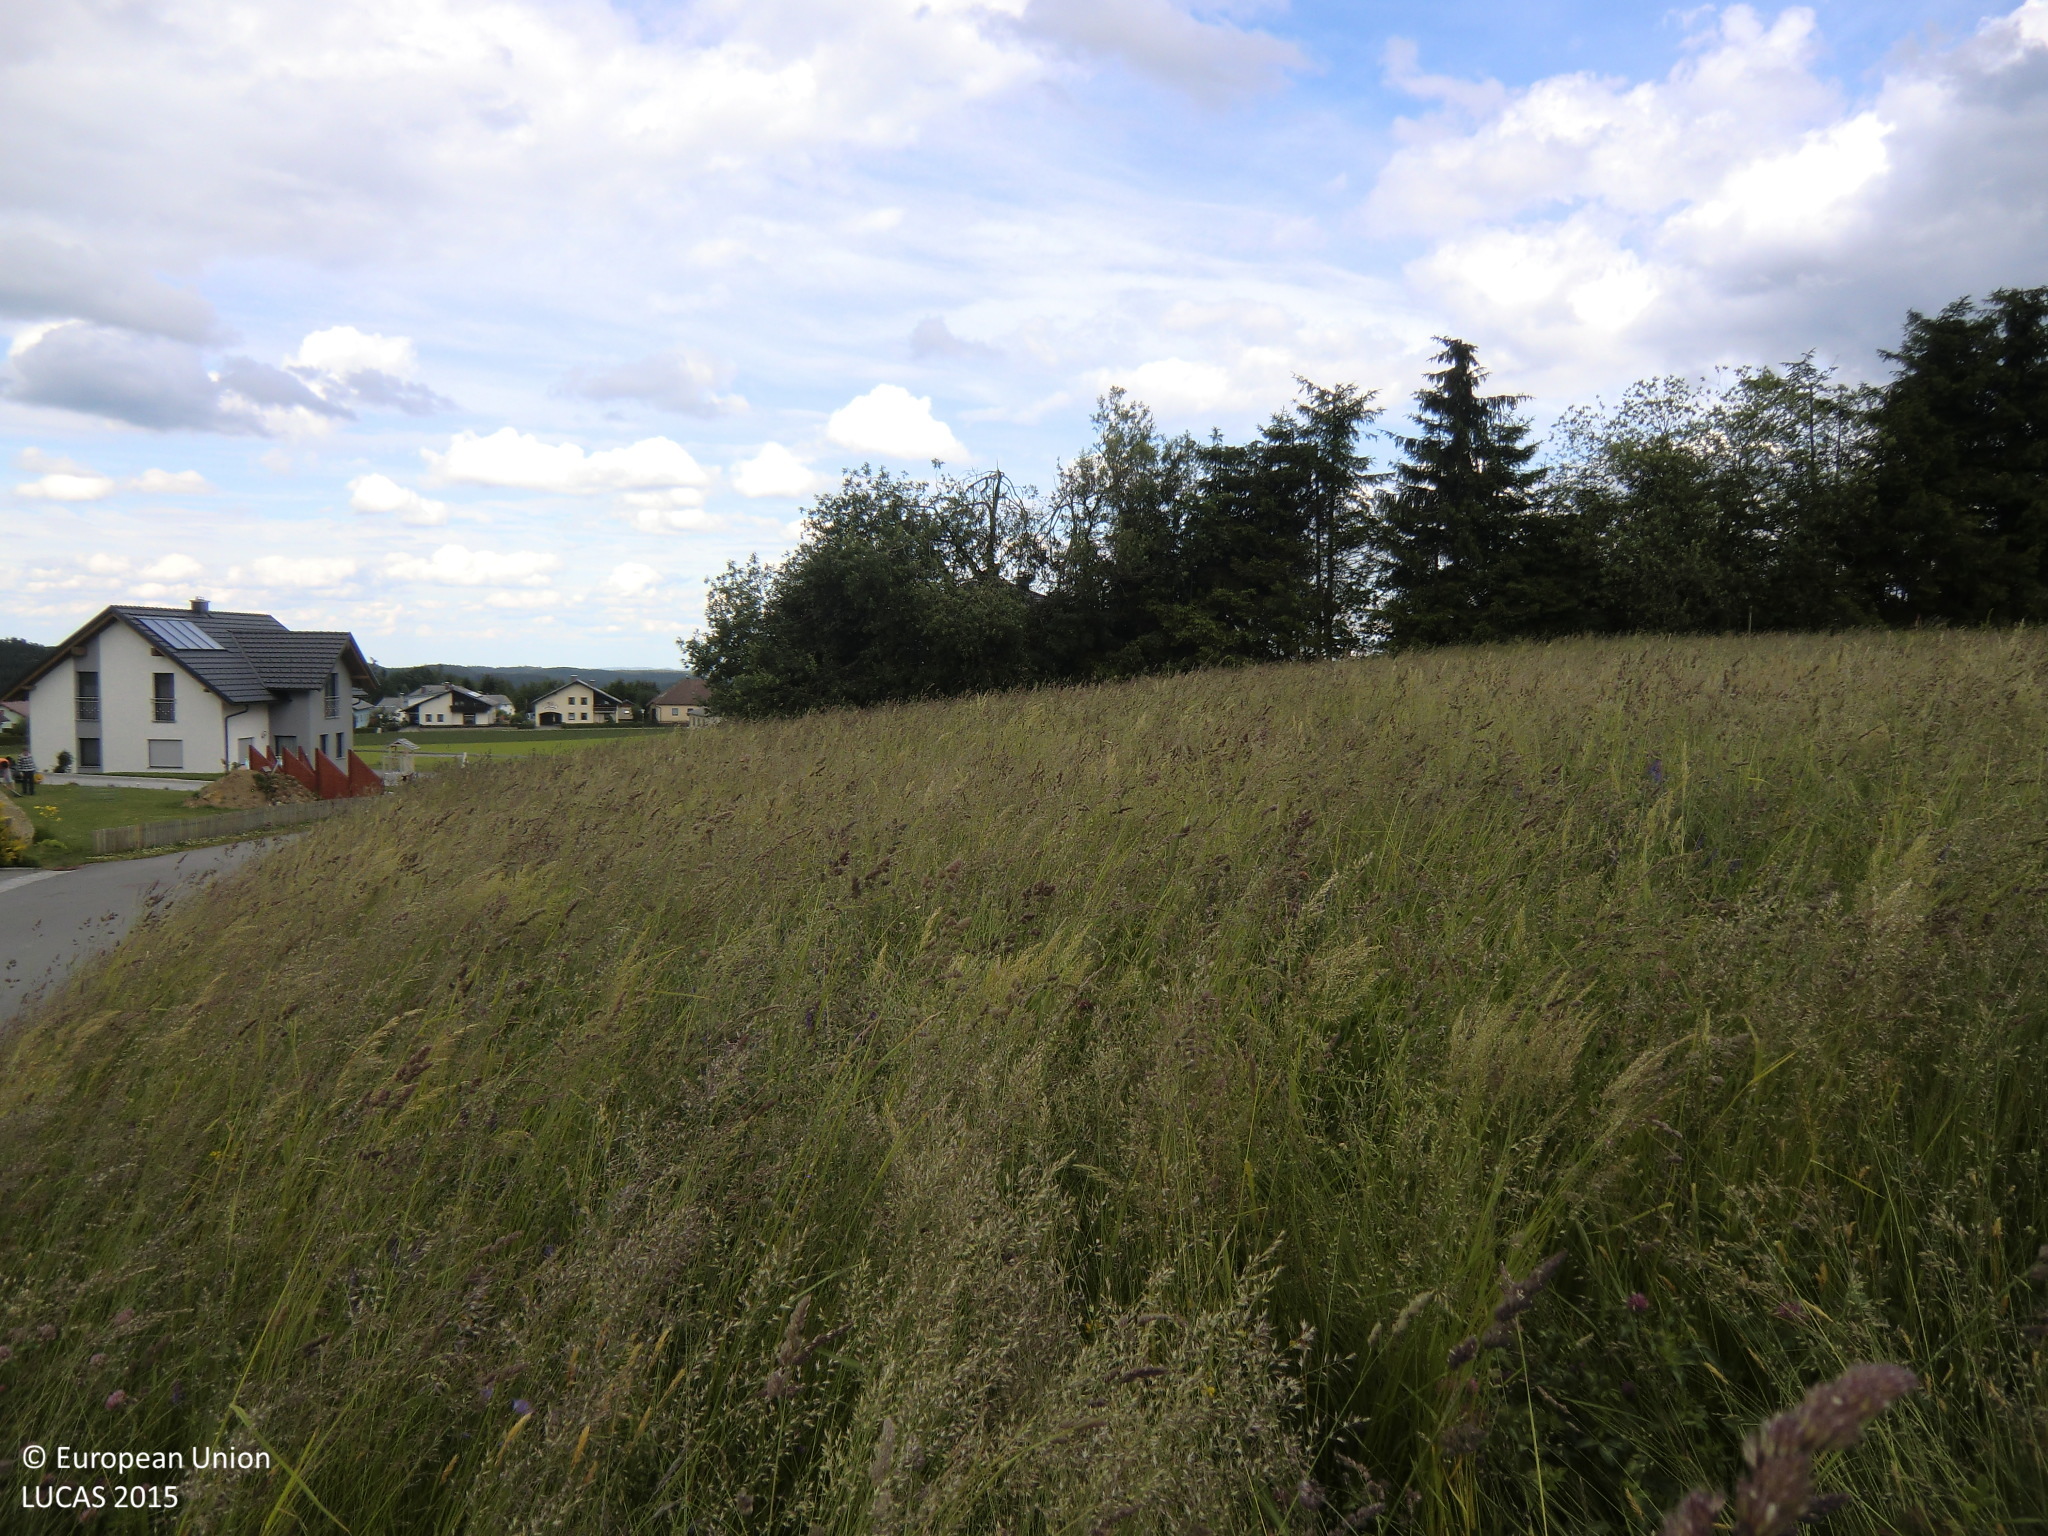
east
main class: Grassland
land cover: Grassland without tree/shrub cover
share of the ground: > 75 %
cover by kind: herbaceous plants 100 %
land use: Agriculture (excluding fallow land and kitchen gardens)
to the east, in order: Grassland without tree/shrub cover; Spruce dominated mixed woodland; Grassland without tree/shrub cover; Artificial constructions in urban areas; Temporary grasslands; Maize; Artificial constructions in urban areas
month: June
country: AT
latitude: 48.5332
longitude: 14.8089
